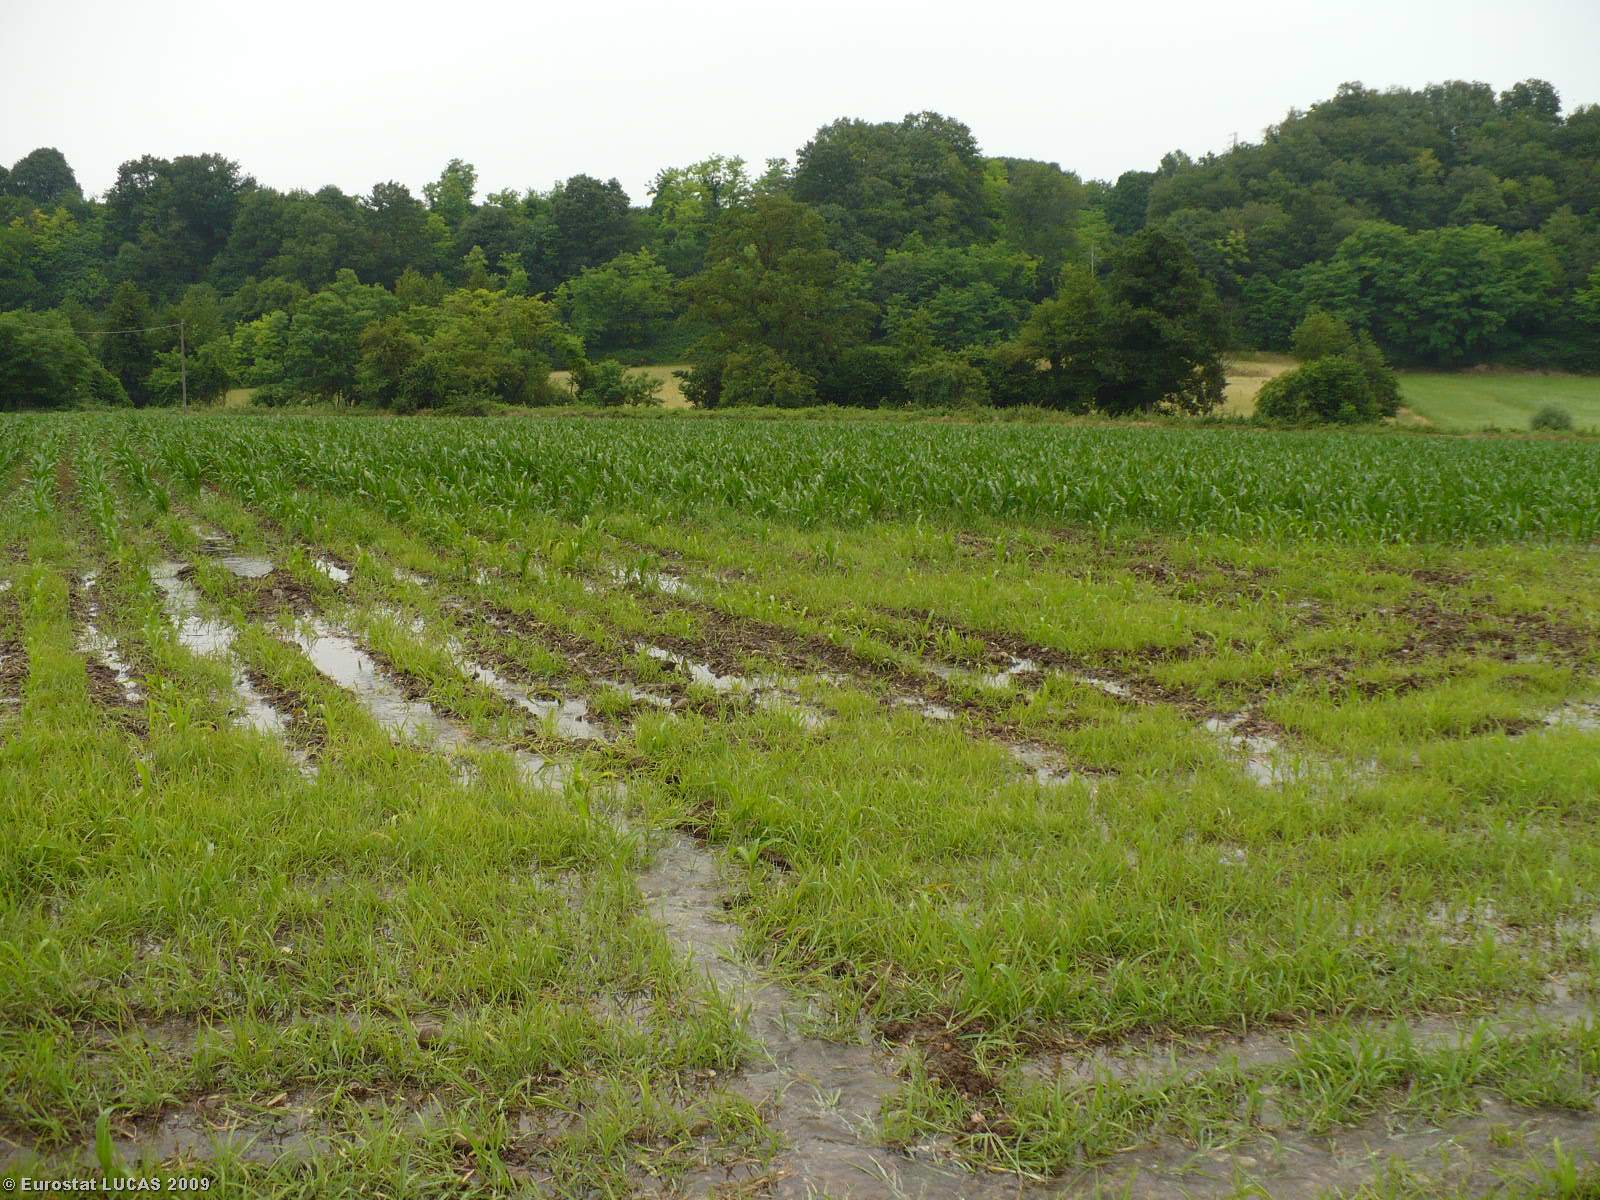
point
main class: Cropland
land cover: Maize
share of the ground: 50 - 75 %
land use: Agriculture (excluding fallow land and kitchen gardens)
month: June
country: IT
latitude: 45.3934
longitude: 10.7778
